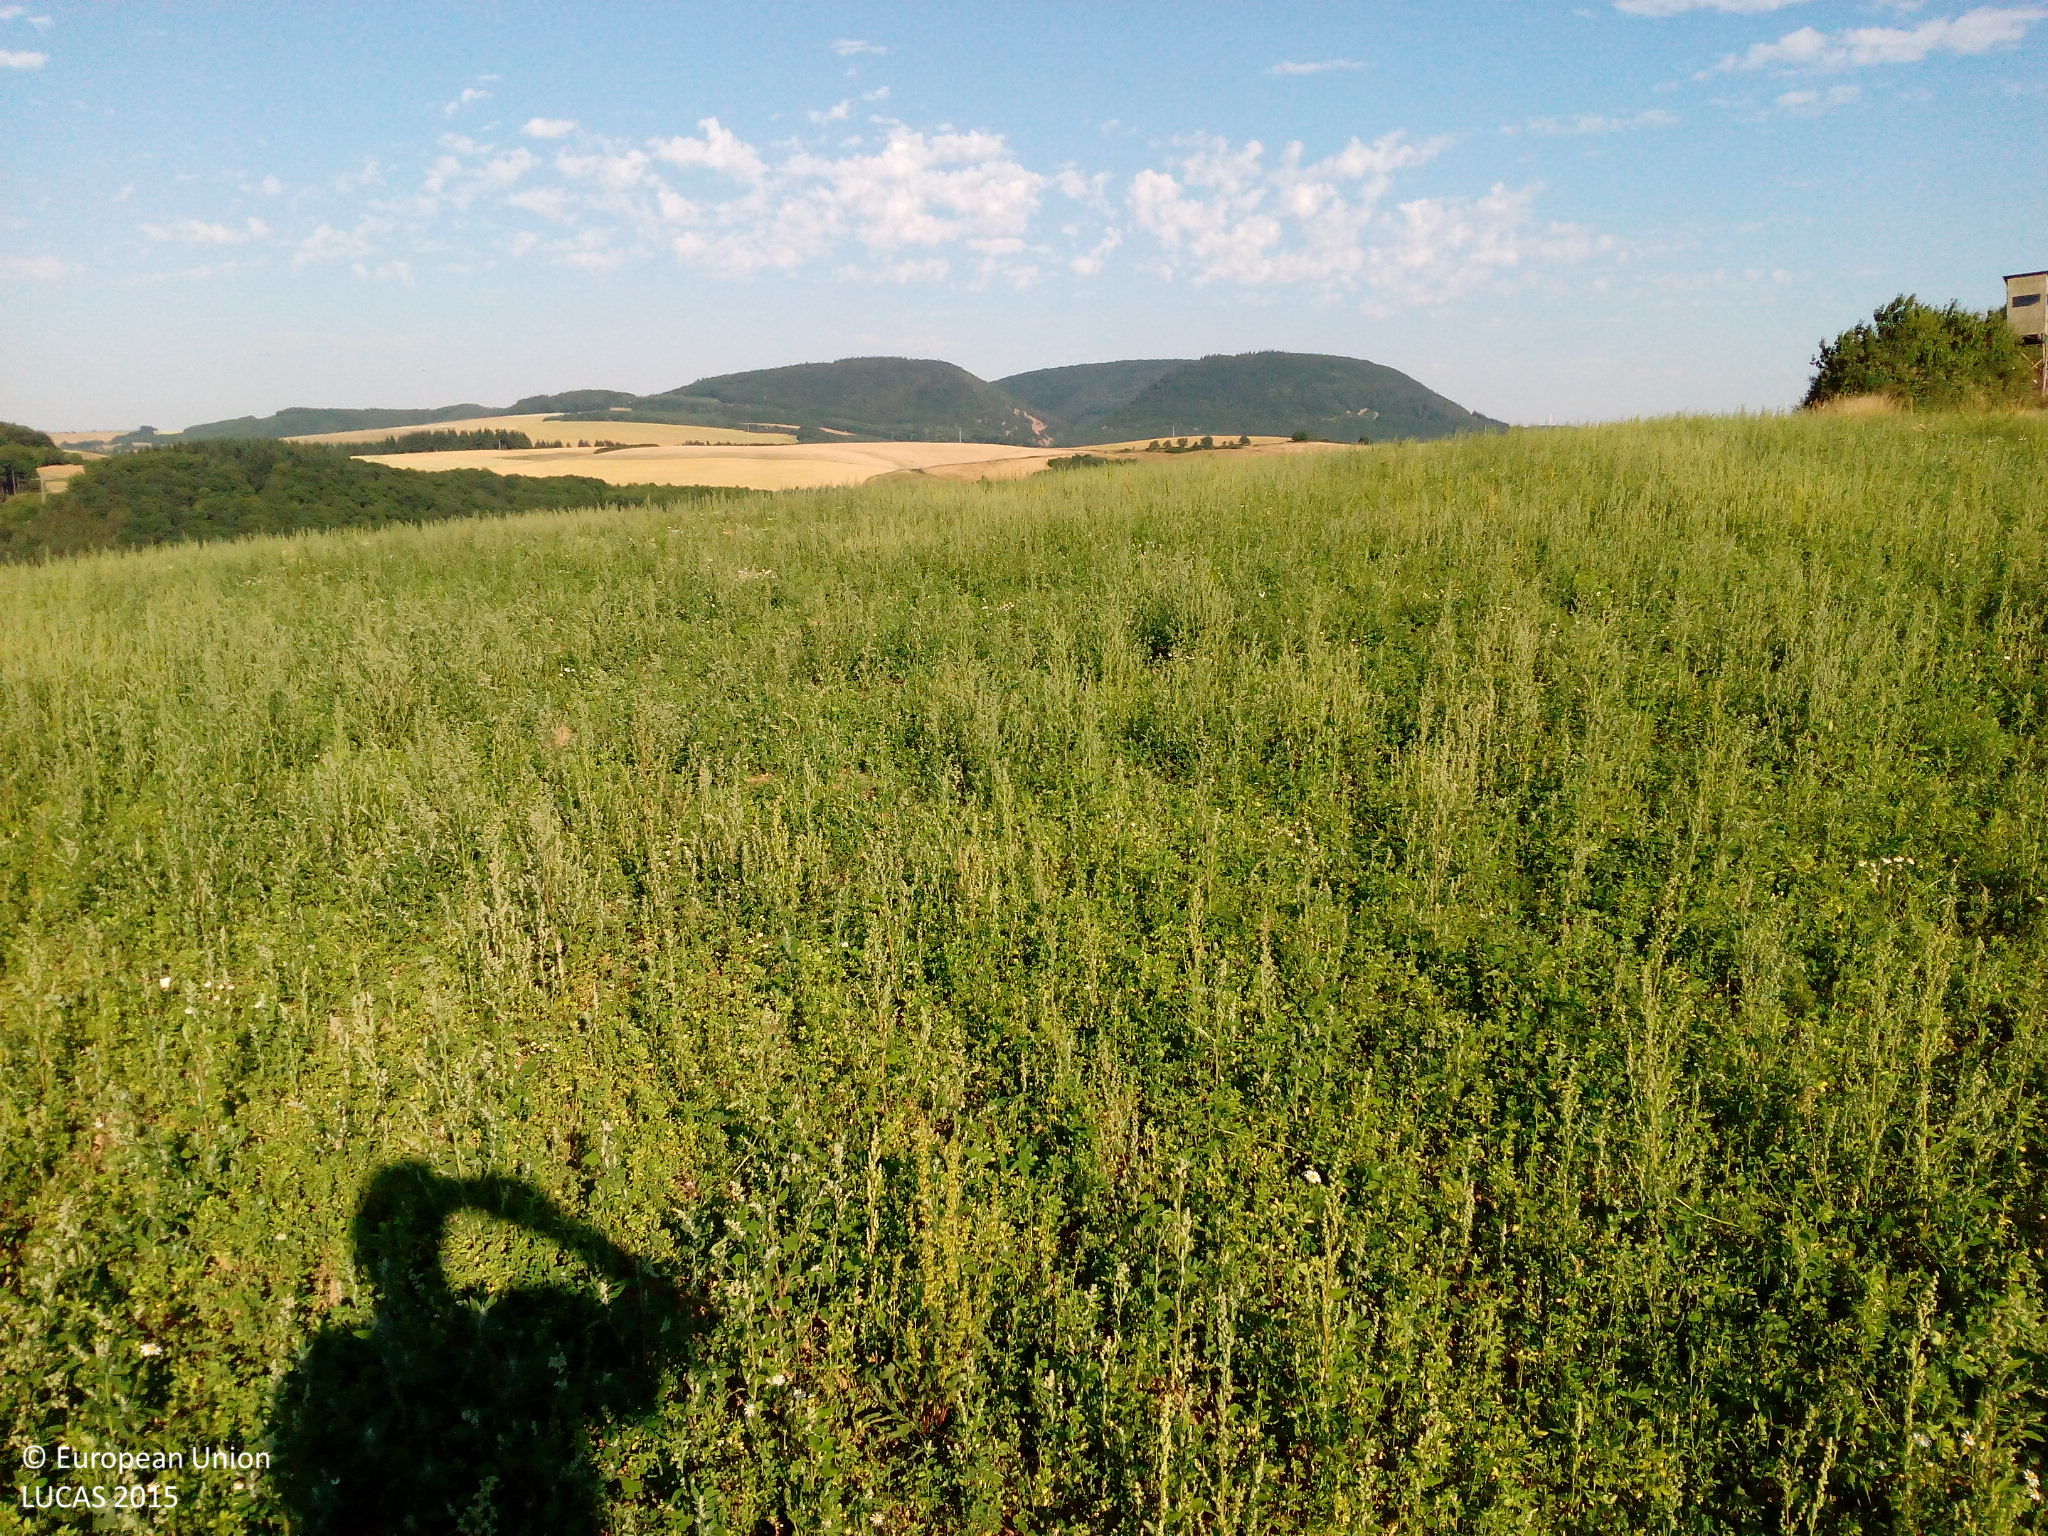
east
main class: Cropland
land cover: Clovers
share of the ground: > 75 %
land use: Agriculture (excluding fallow land and kitchen gardens)
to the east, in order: Clovers; Barley
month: July
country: DE
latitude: 49.5996
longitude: 7.5237
